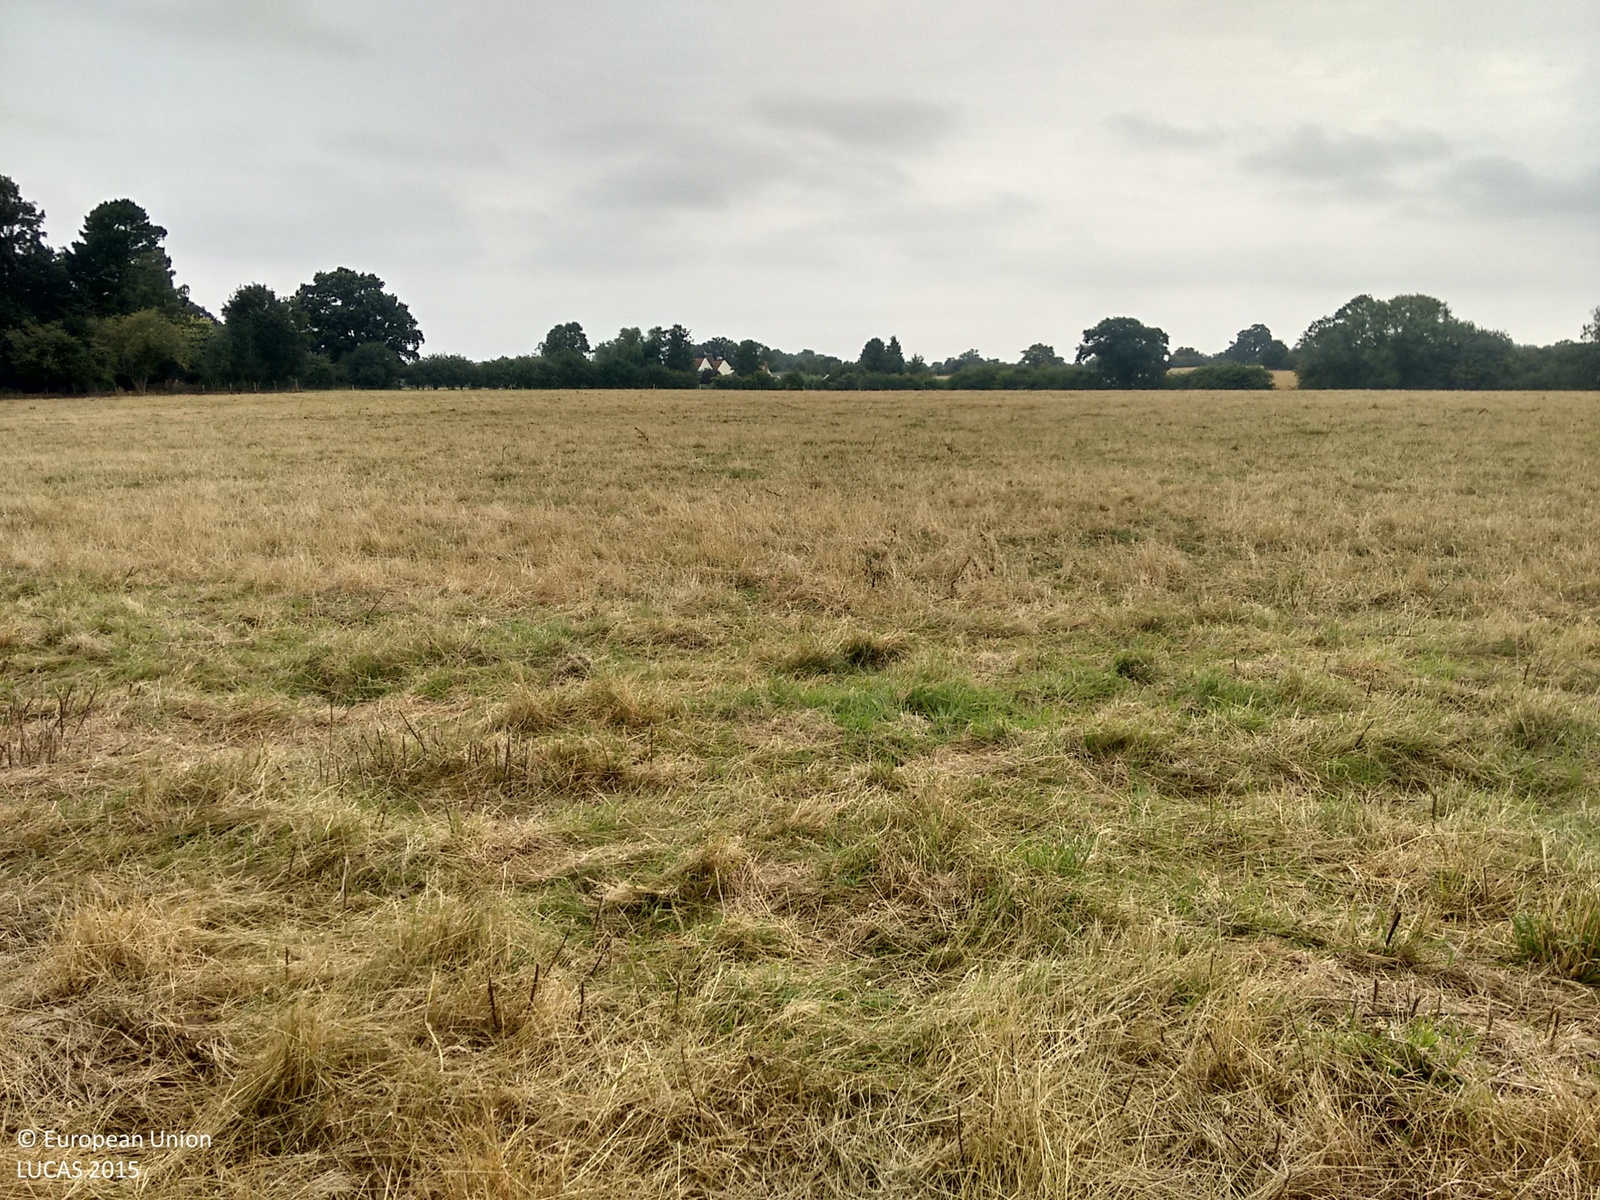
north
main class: Grassland
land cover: Grassland without tree/shrub cover
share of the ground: > 75 %
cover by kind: herbaceous plants 100 %
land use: Agriculture (excluding fallow land and kitchen gardens)
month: August
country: GB
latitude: 52.0003
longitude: 1.0188
